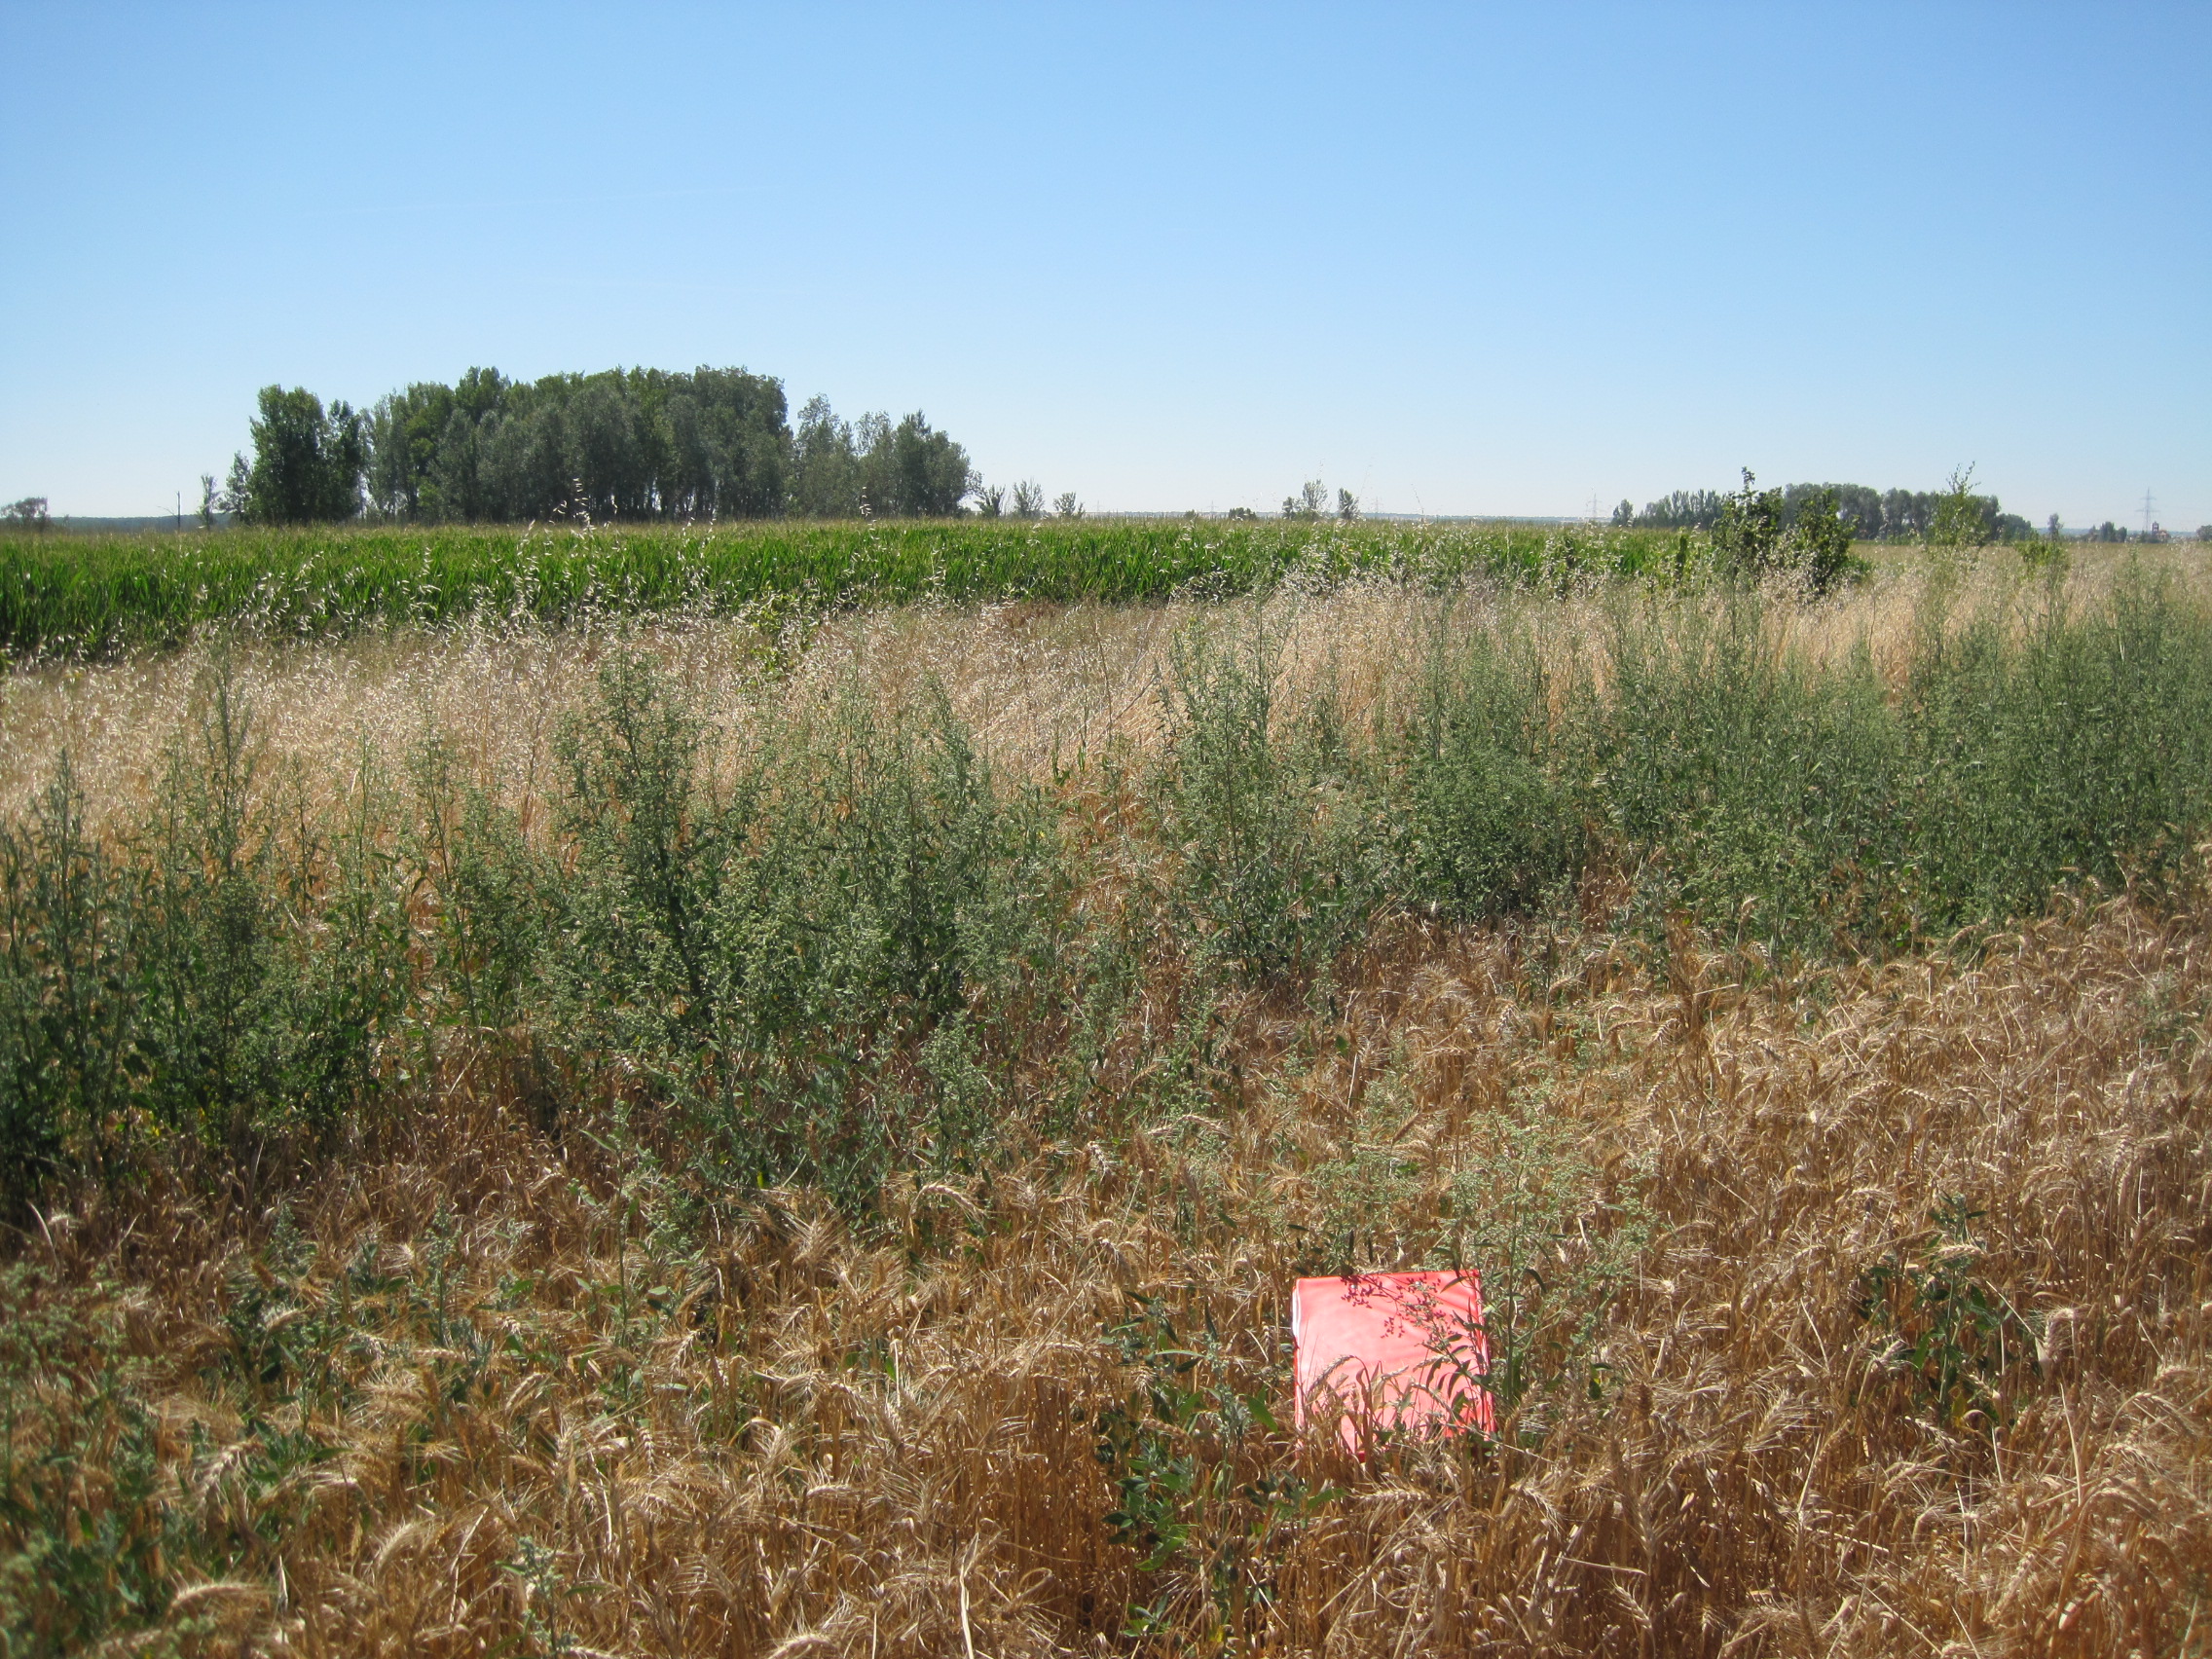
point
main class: Cropland
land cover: Common wheat
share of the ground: > 75 %
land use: Agriculture (excluding fallow land and kitchen gardens)
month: July
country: ES
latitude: 42.1711
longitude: -5.5992
